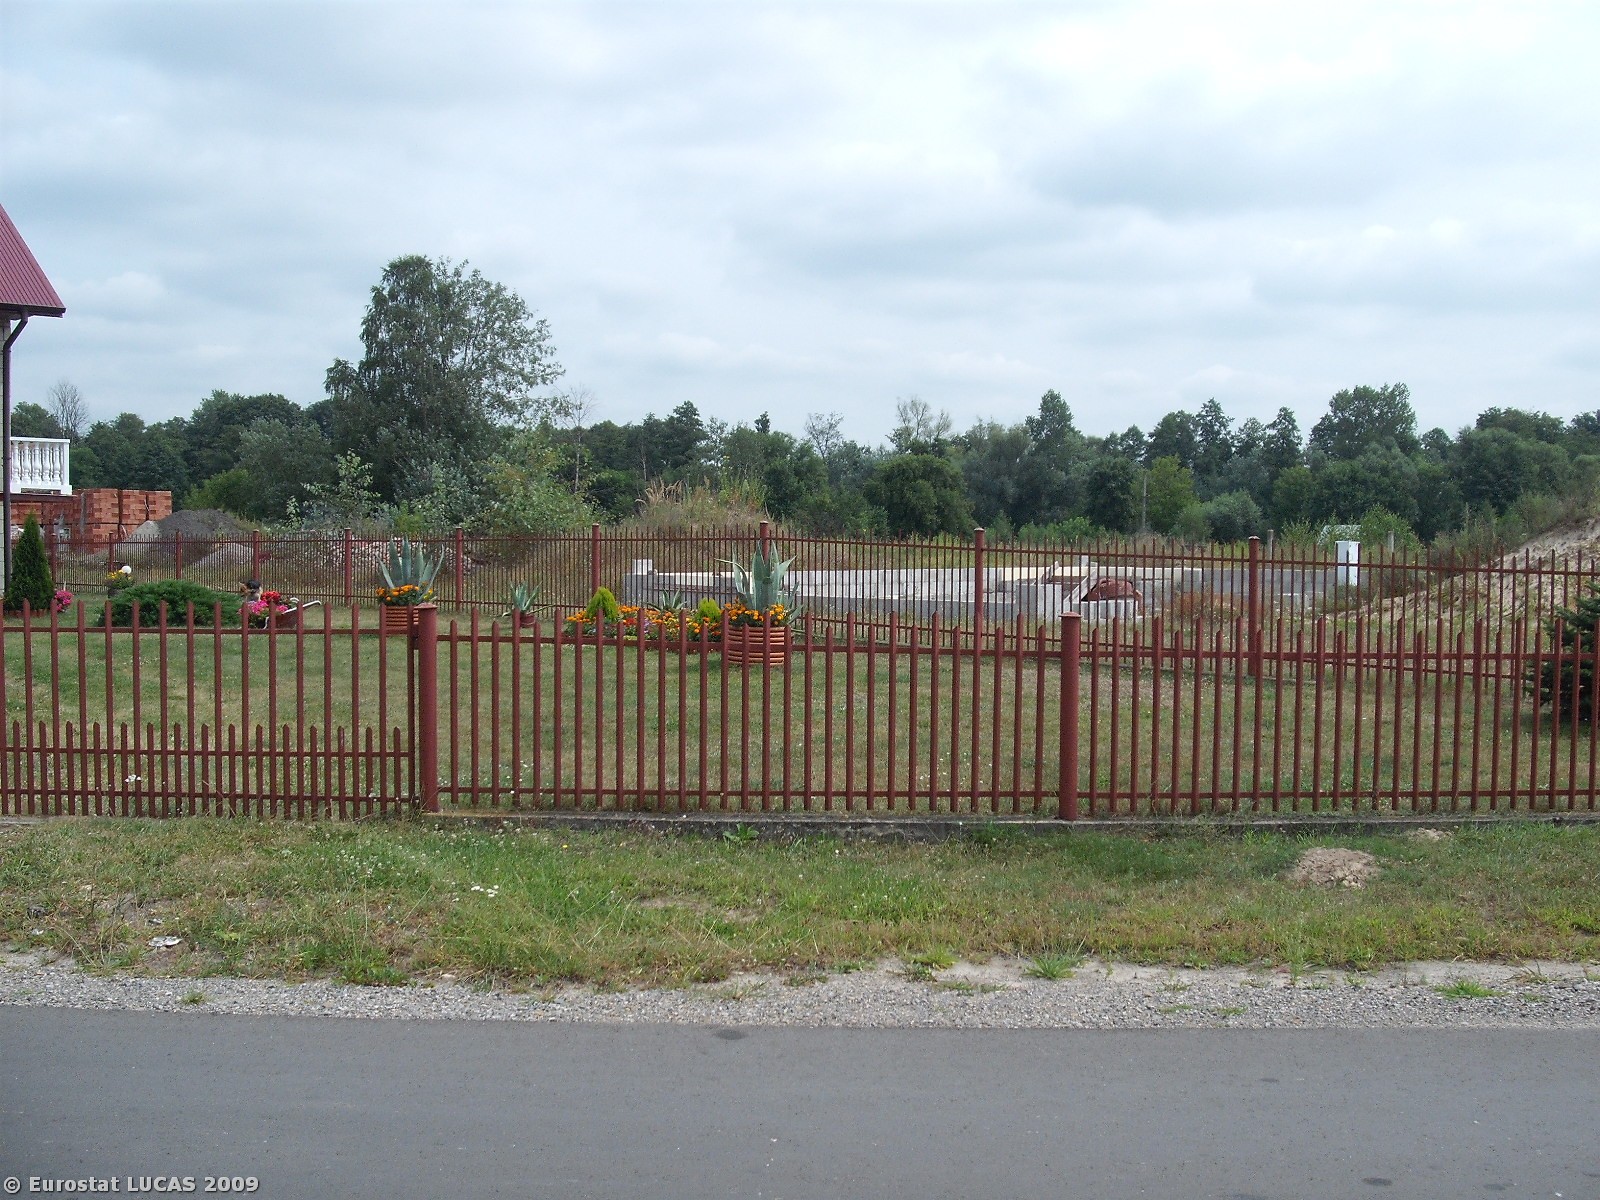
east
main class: Grassland
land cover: Grassland without tree/shrub cover
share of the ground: > 75 %
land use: Residential
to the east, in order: Grassland without tree/shrub cover; Artificial constructions in urban areas; Potatoes; Coniferous woodland; Grassland without tree/shrub cover; Lines of trees; Grassland with sparse tree/shrub cover; Broadleaved woodland; Other fruit trees and berries; Mixed woodland; Grassland with sparse tree/shrub cover; Grassland without tree/shrub cover
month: August
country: PL
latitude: 50.5199
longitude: 21.2032
